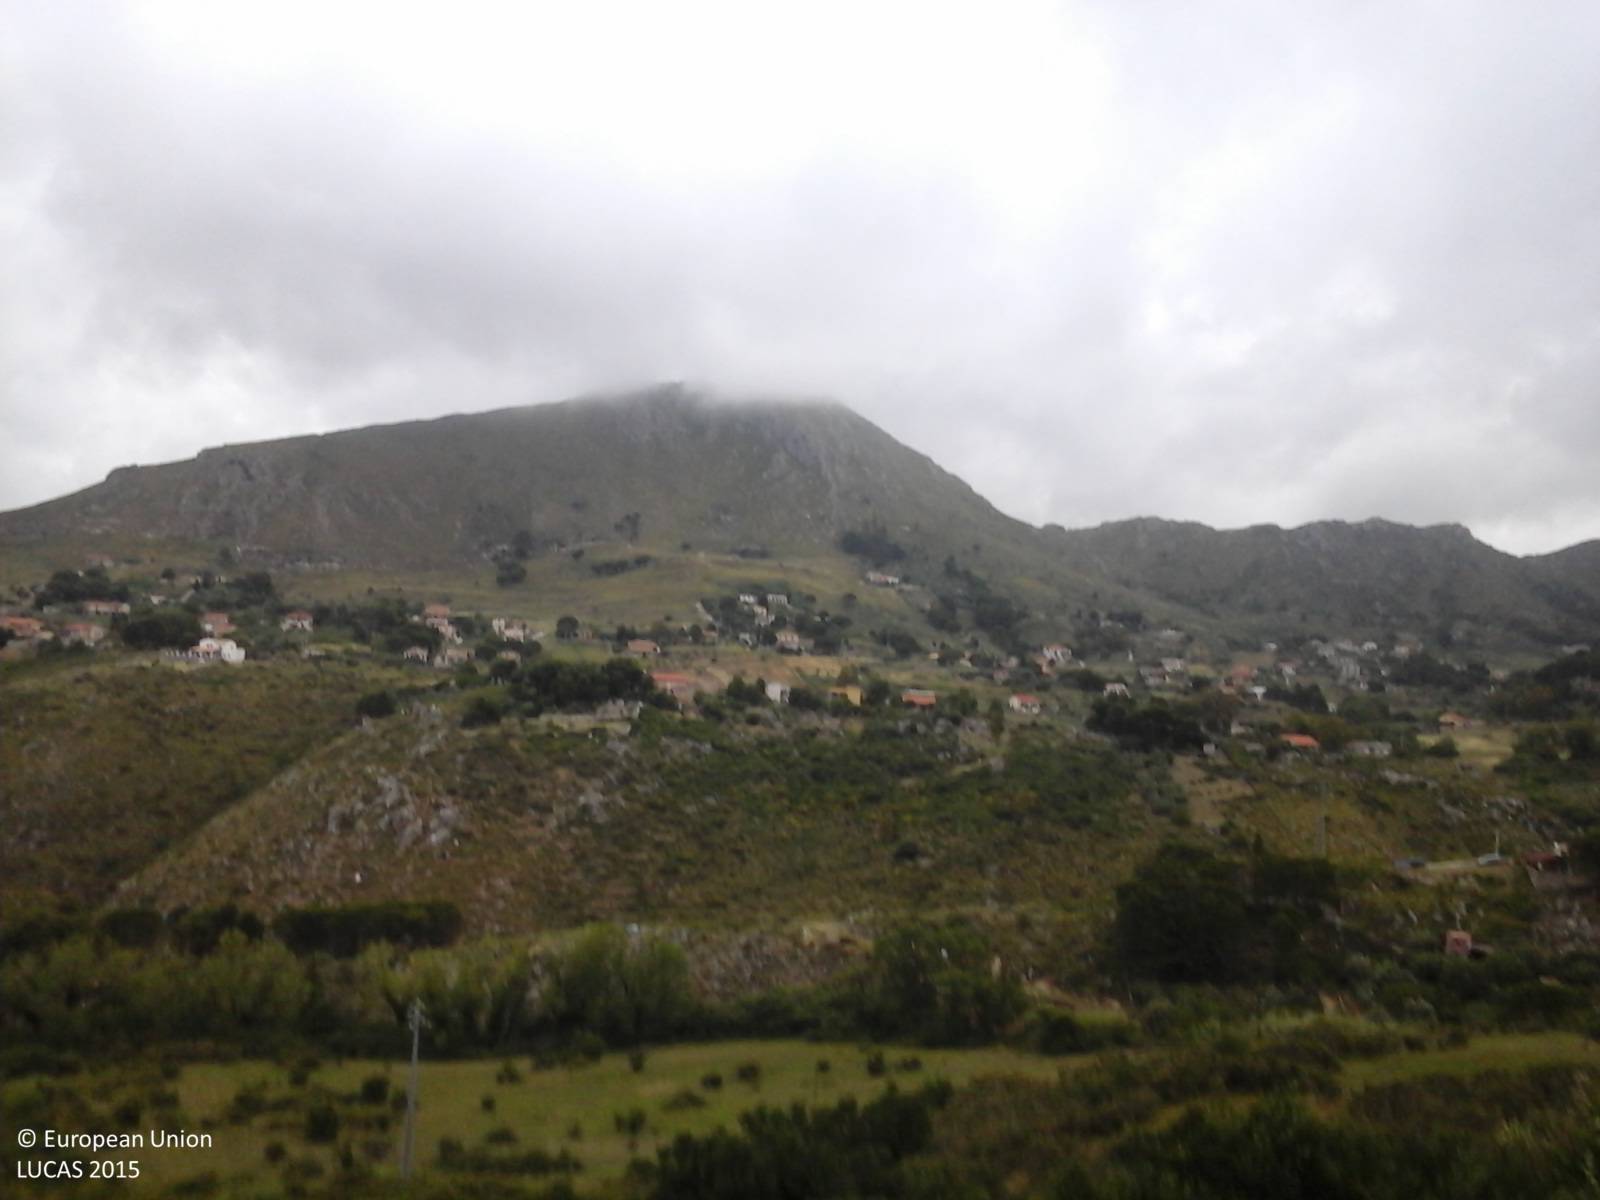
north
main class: Shrubland
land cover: Shrubland without tree cover
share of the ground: > 75 %
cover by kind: shrubs 90 %, herbaceous plants 10 %
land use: Agriculture (excluding fallow land and kitchen gardens)
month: June
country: IT
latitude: 38.0750
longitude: 13.2035
